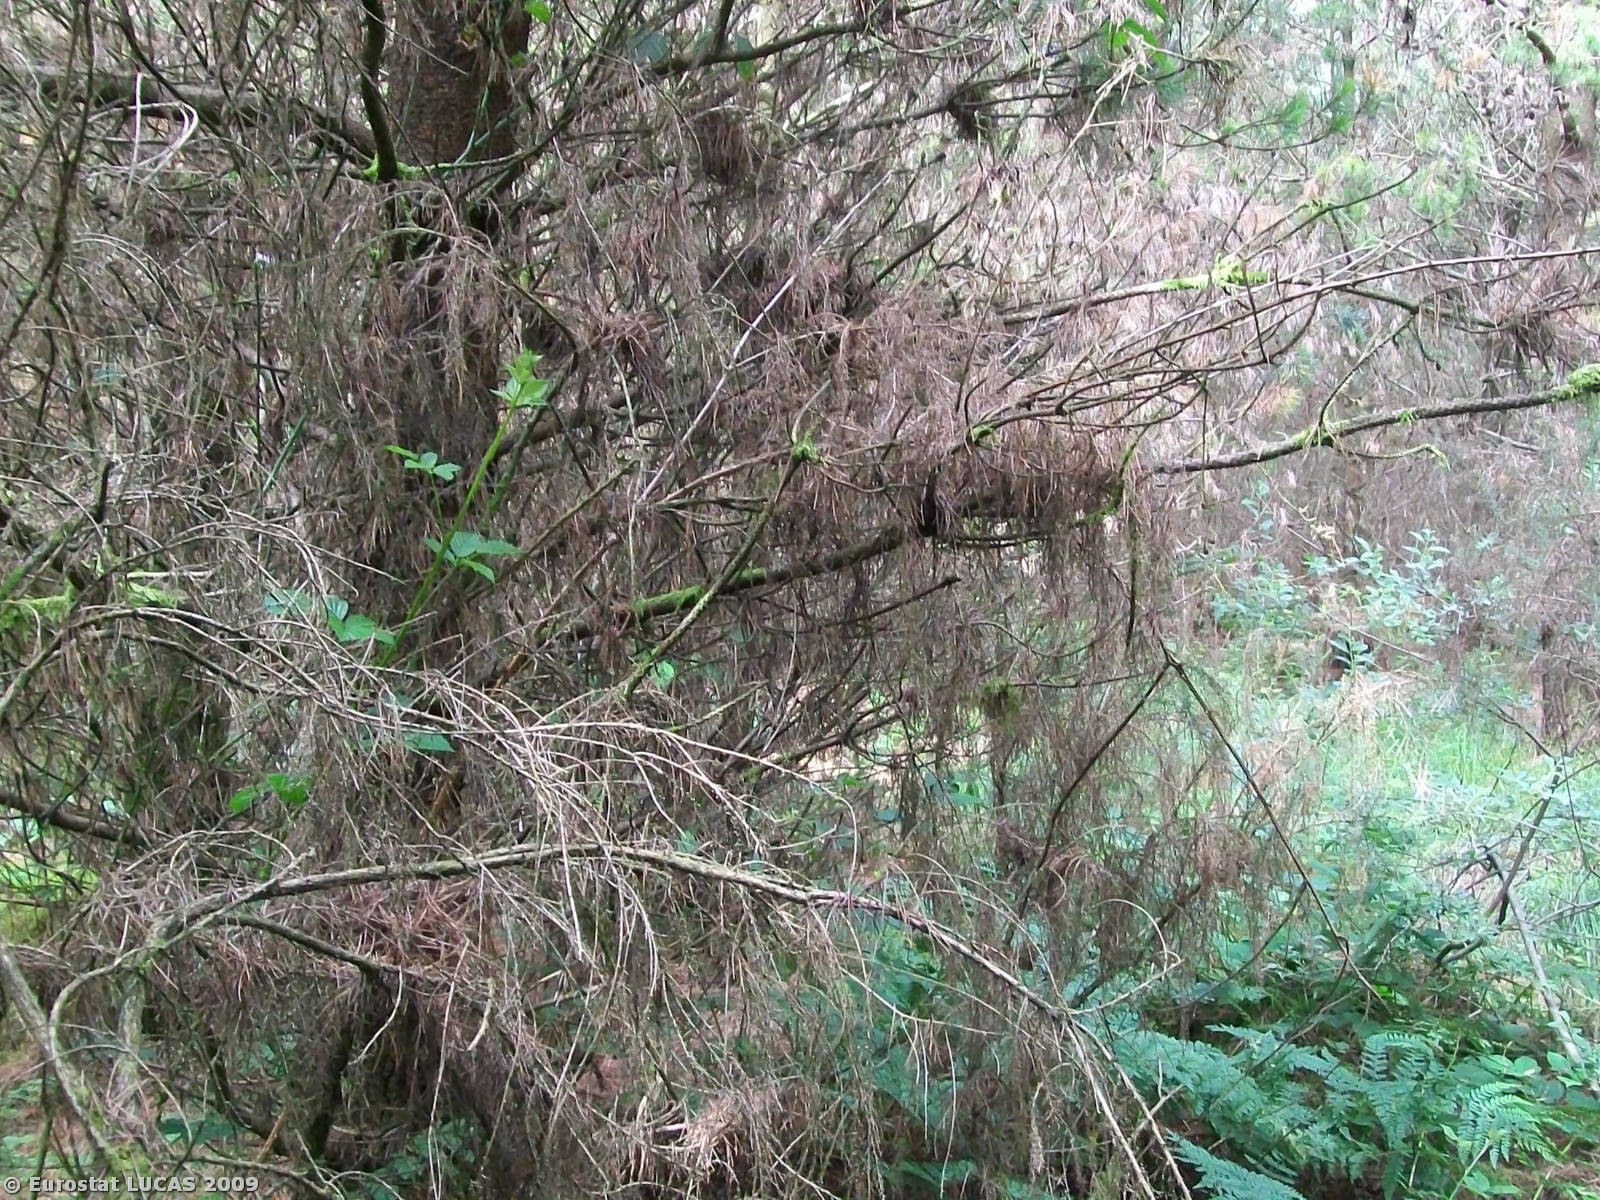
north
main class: Woodland
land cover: Coniferous woodland
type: plantations and self-sown exotic forest
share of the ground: > 75 %
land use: Forestry
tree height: > 5 m
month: July
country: GB
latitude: 55.2061
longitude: -6.3173
